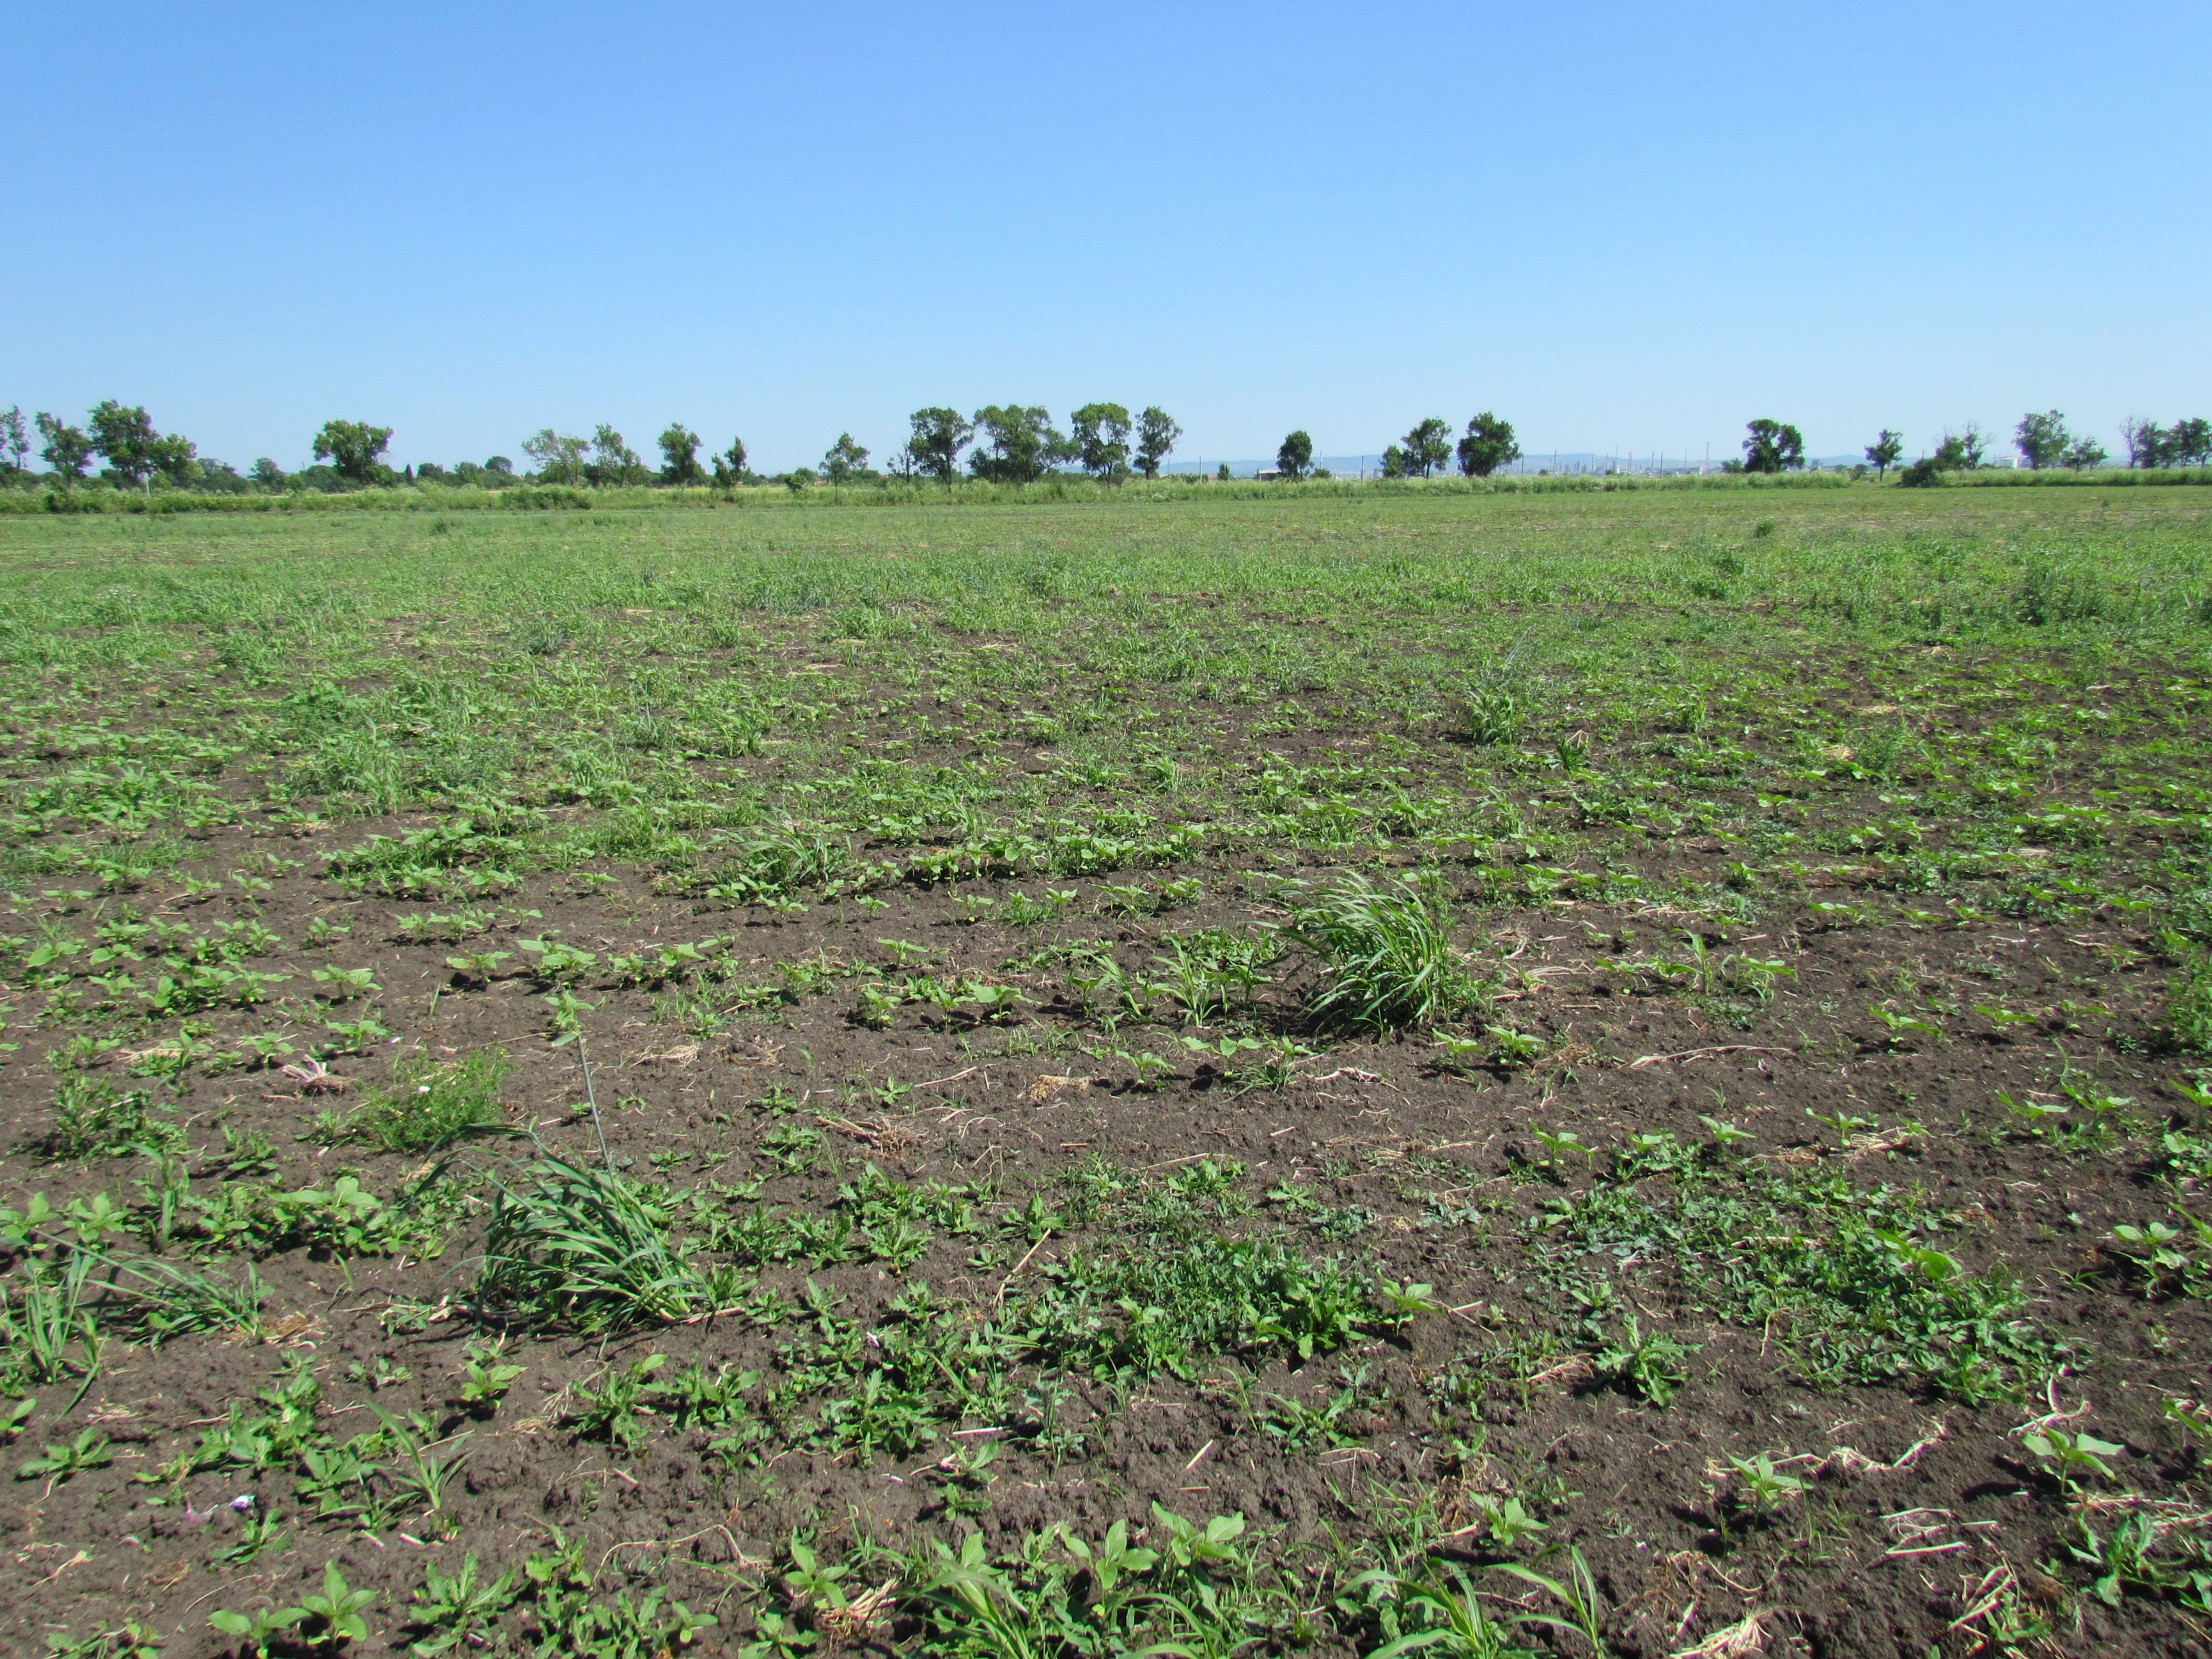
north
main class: Cropland
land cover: Sunflower
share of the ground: 10 - 25 %
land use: Agriculture (excluding fallow land and kitchen gardens)
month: June
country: BG
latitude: 42.4961
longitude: 27.3056
